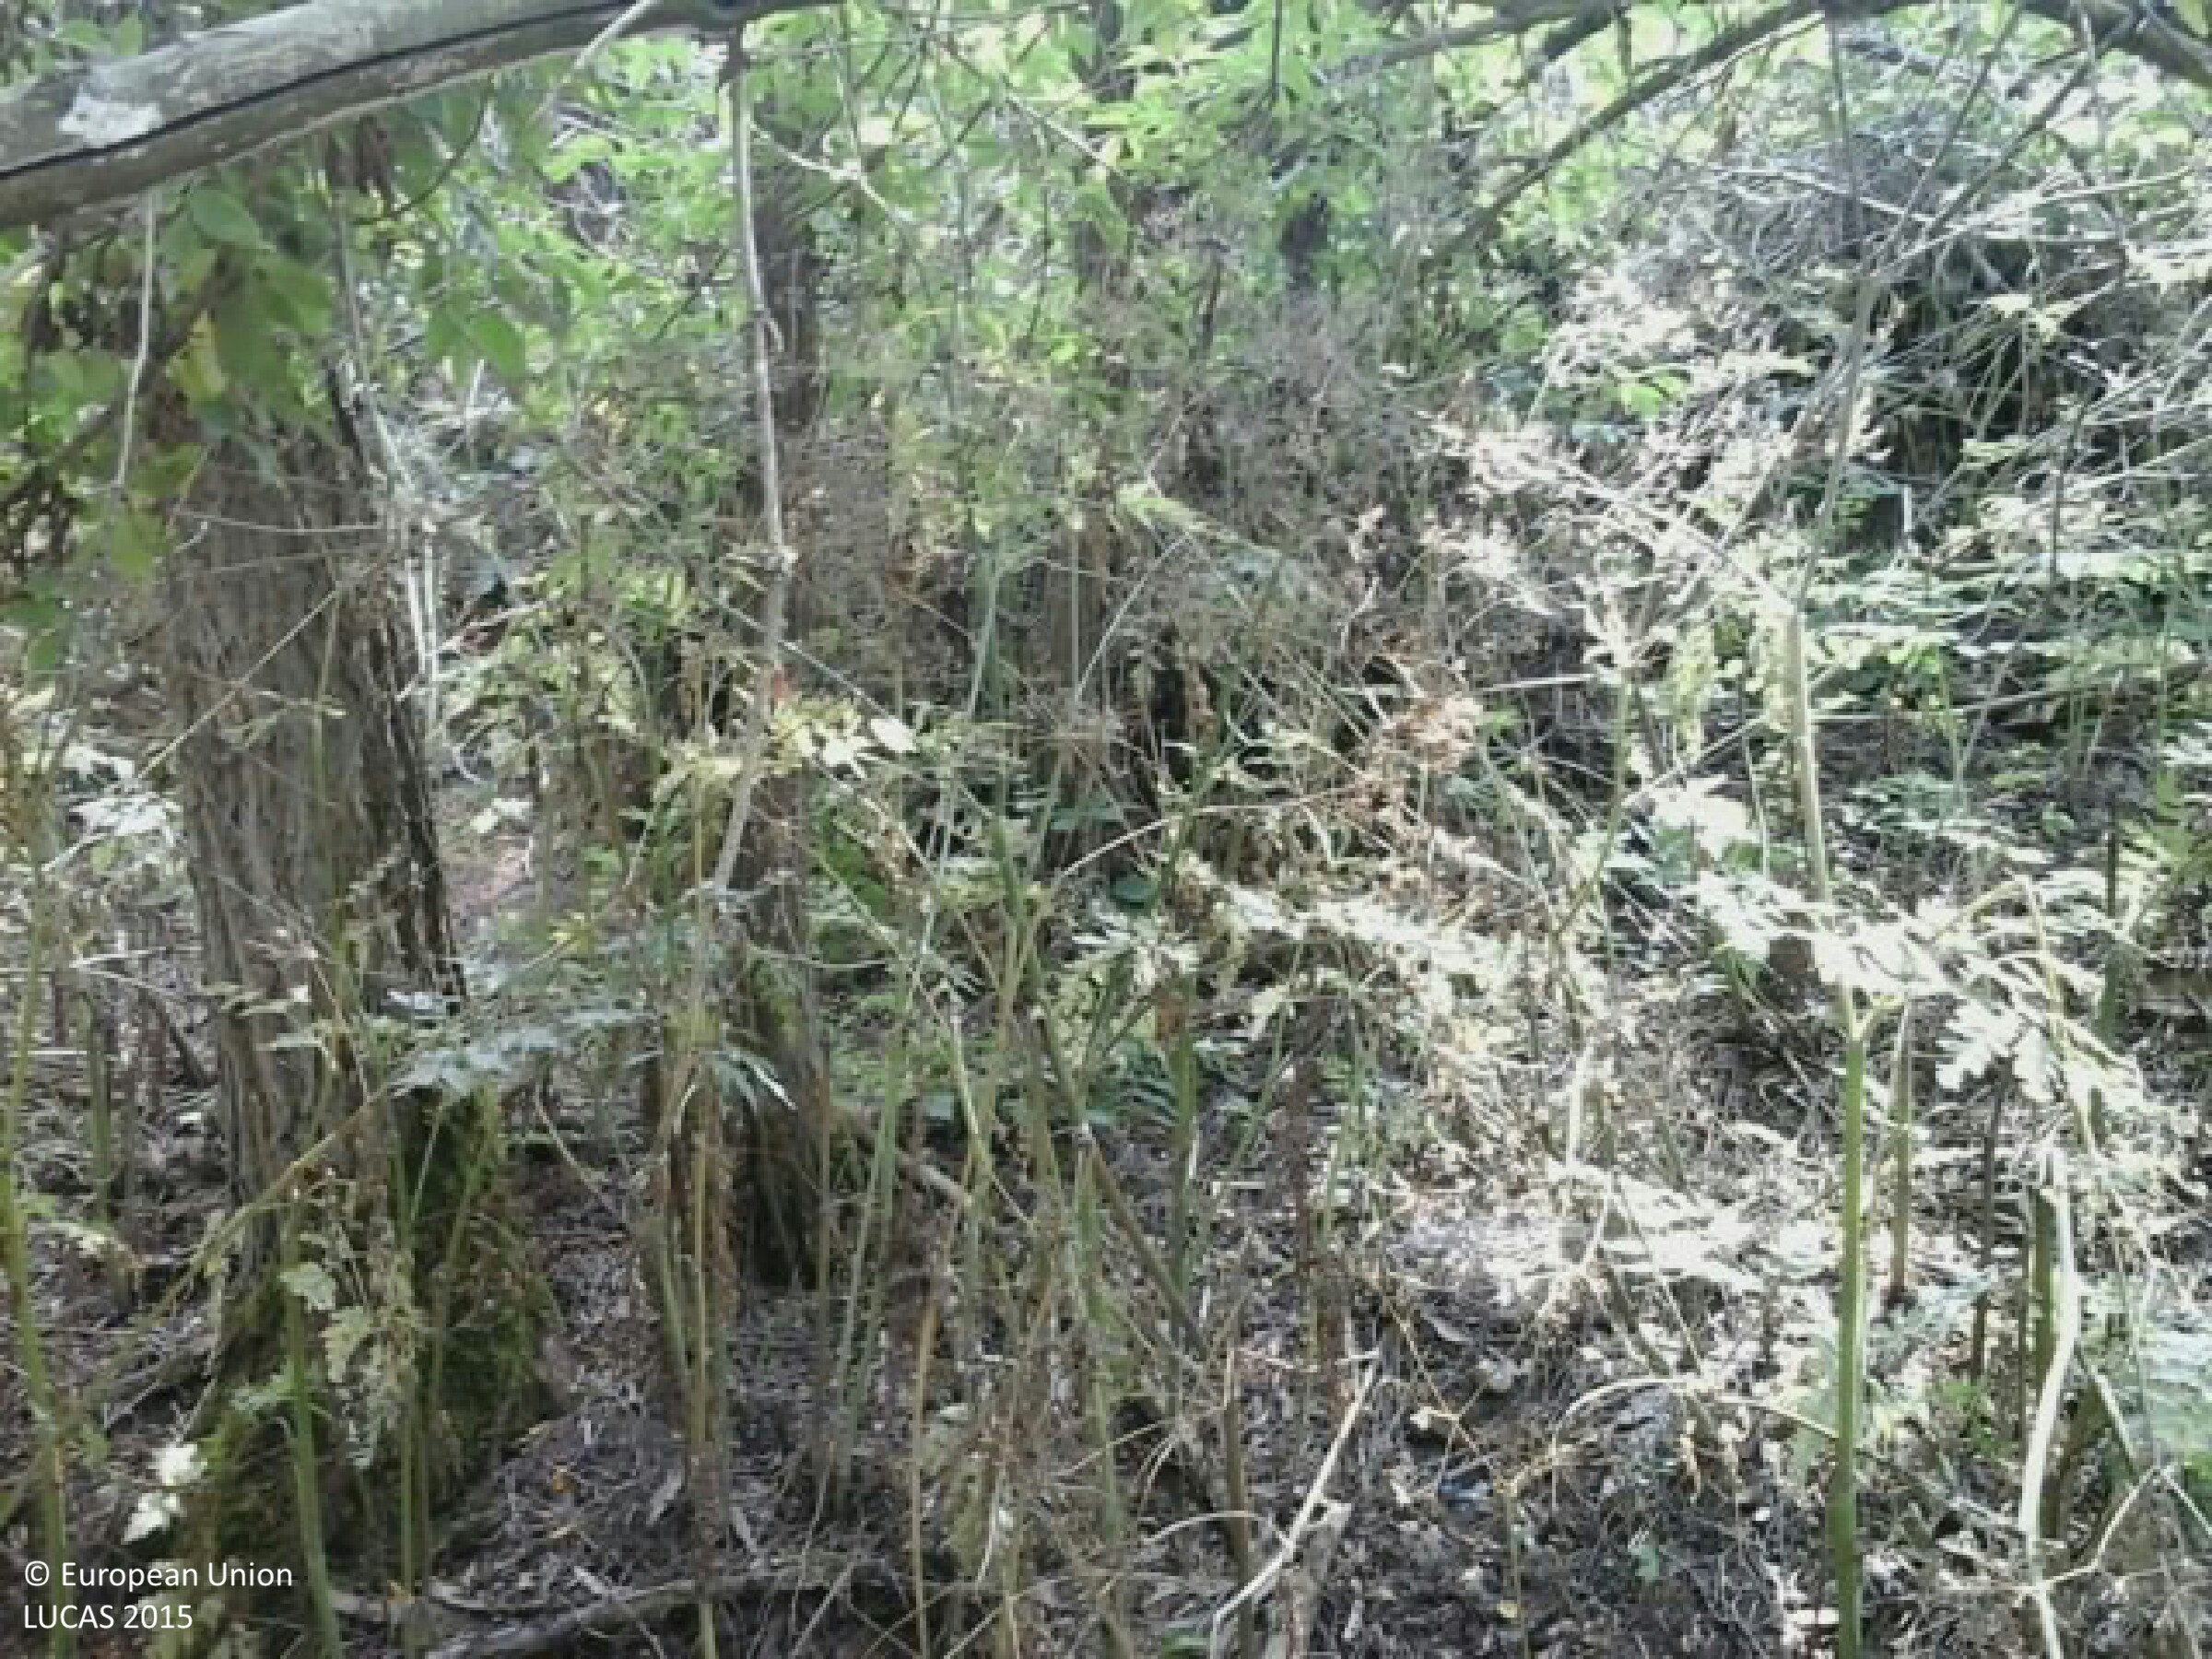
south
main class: Woodland
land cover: Broadleaved woodland
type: mesophytic deciduous forest
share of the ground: > 75 %
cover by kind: broadleaved forest trees 100 %
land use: Forestry
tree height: > 5 m
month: July
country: HU
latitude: 47.7712
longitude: 19.3485
